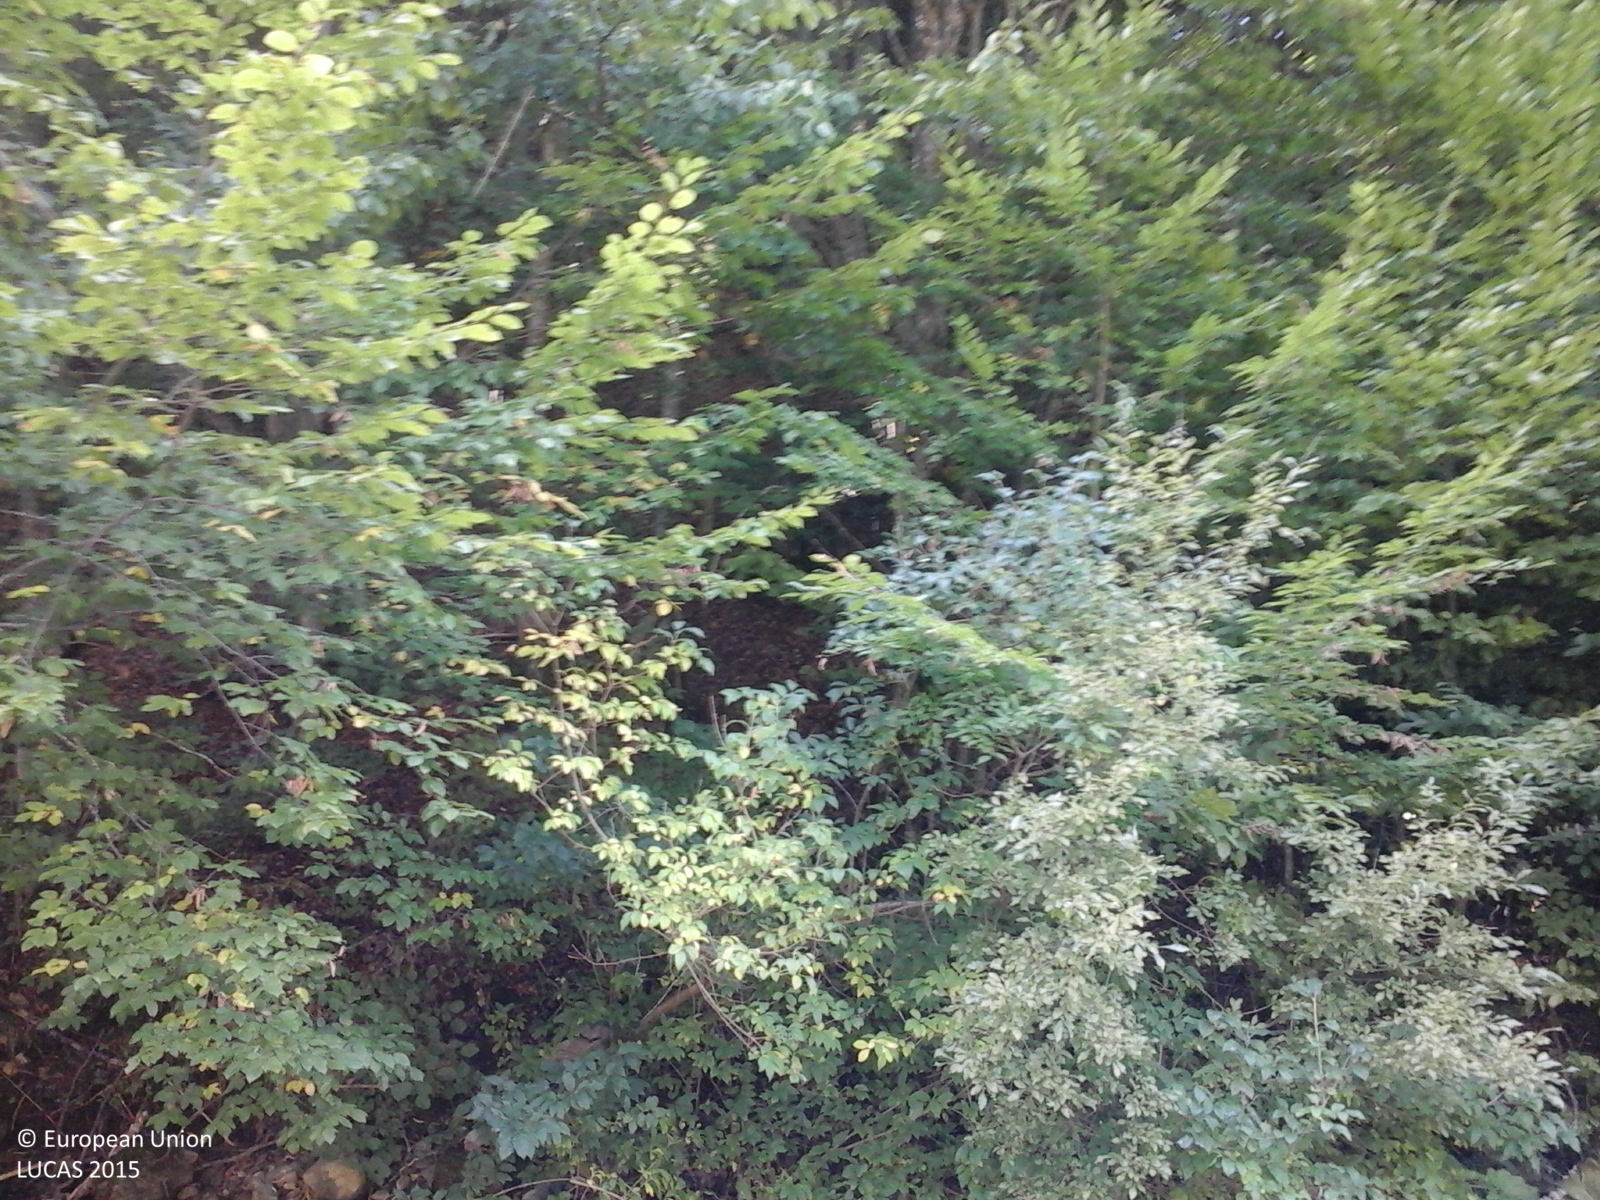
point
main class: Woodland
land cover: Other mixed woodland
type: acidophilous oak and oak-birch forest
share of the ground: > 75 %
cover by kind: broadleaved forest trees 75 %, coniferous forest trees 25 %
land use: Forestry
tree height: > 5 m
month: September
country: RO
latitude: 46.7556
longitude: 22.5563
